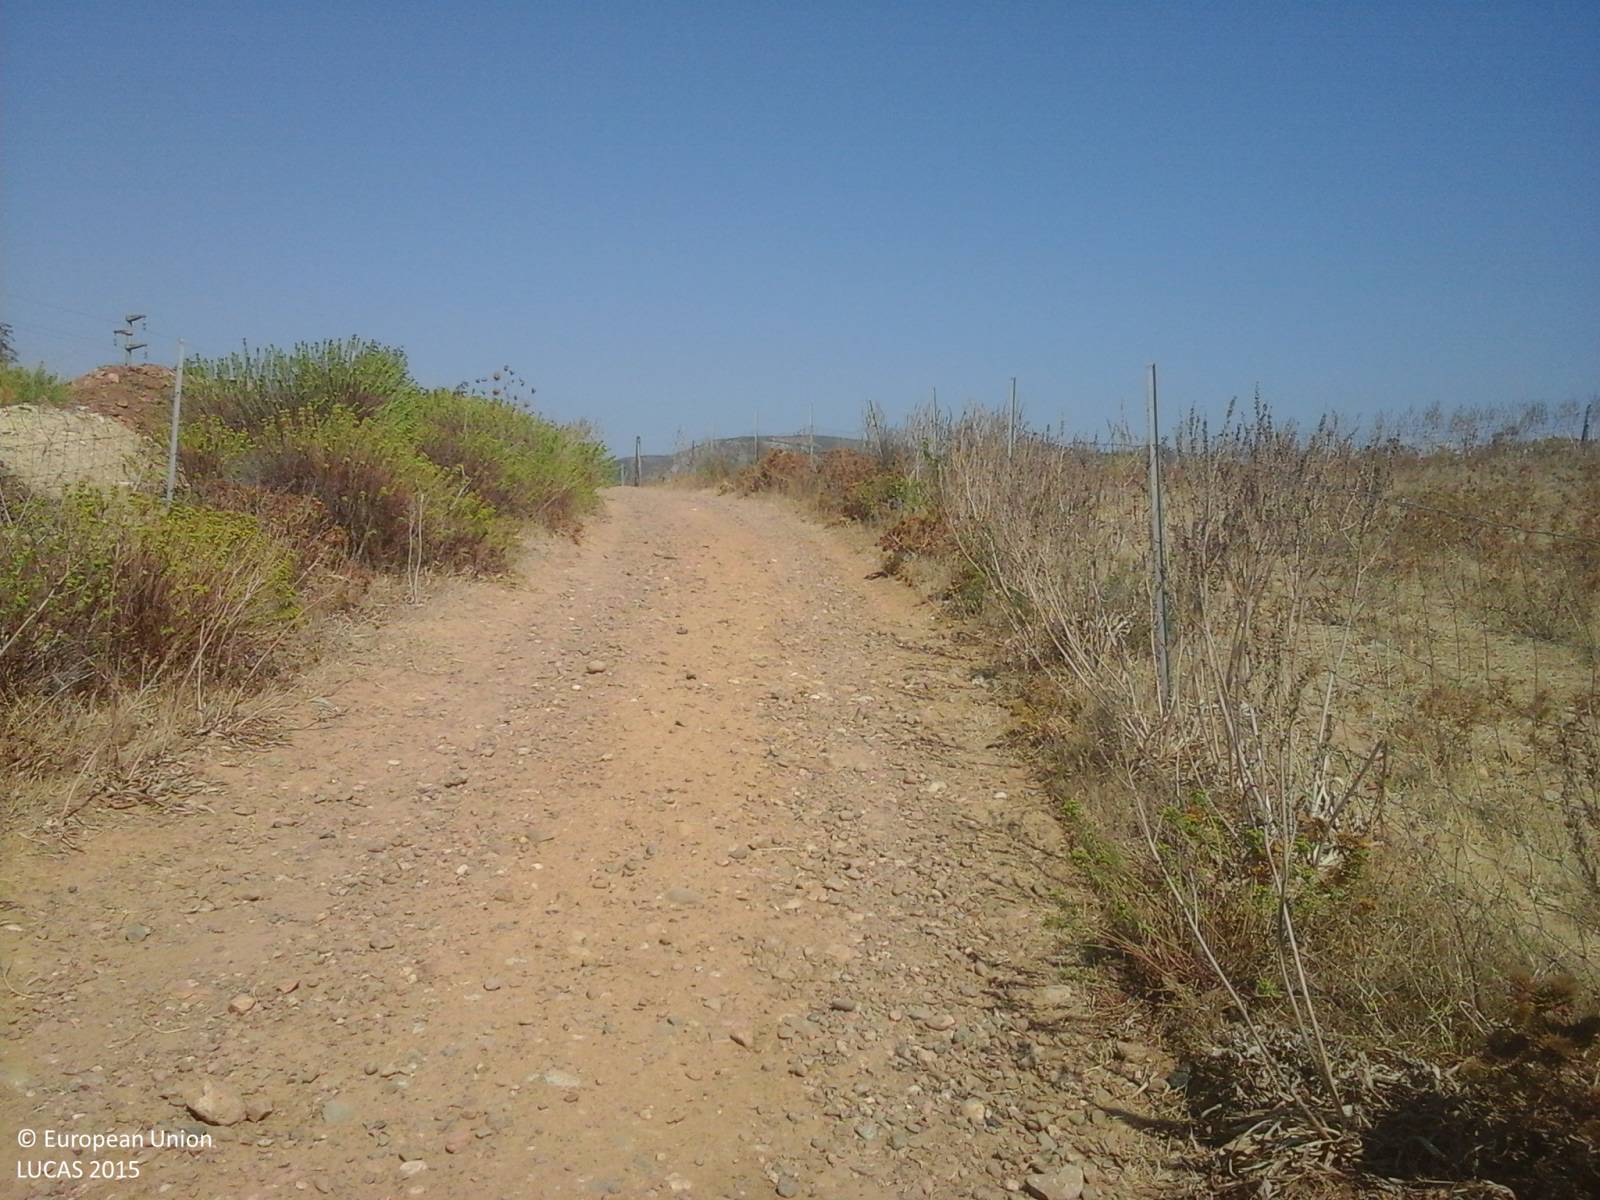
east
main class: Cropland
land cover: Barley
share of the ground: > 75 %
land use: Agriculture (excluding fallow land and kitchen gardens)
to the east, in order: Barley; Fences; Spontaneously vegetated surfaces; Tracks; Electric lines; Abandoned hedges; Grassland without tree/shrub cover; Vineyards; Grassland without tree/shrub cover; Tracks; Managed hedges; Electric lines; Fences; Spontaneously vegetated surfaces
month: July
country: IT
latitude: 39.2047
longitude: 8.4693
